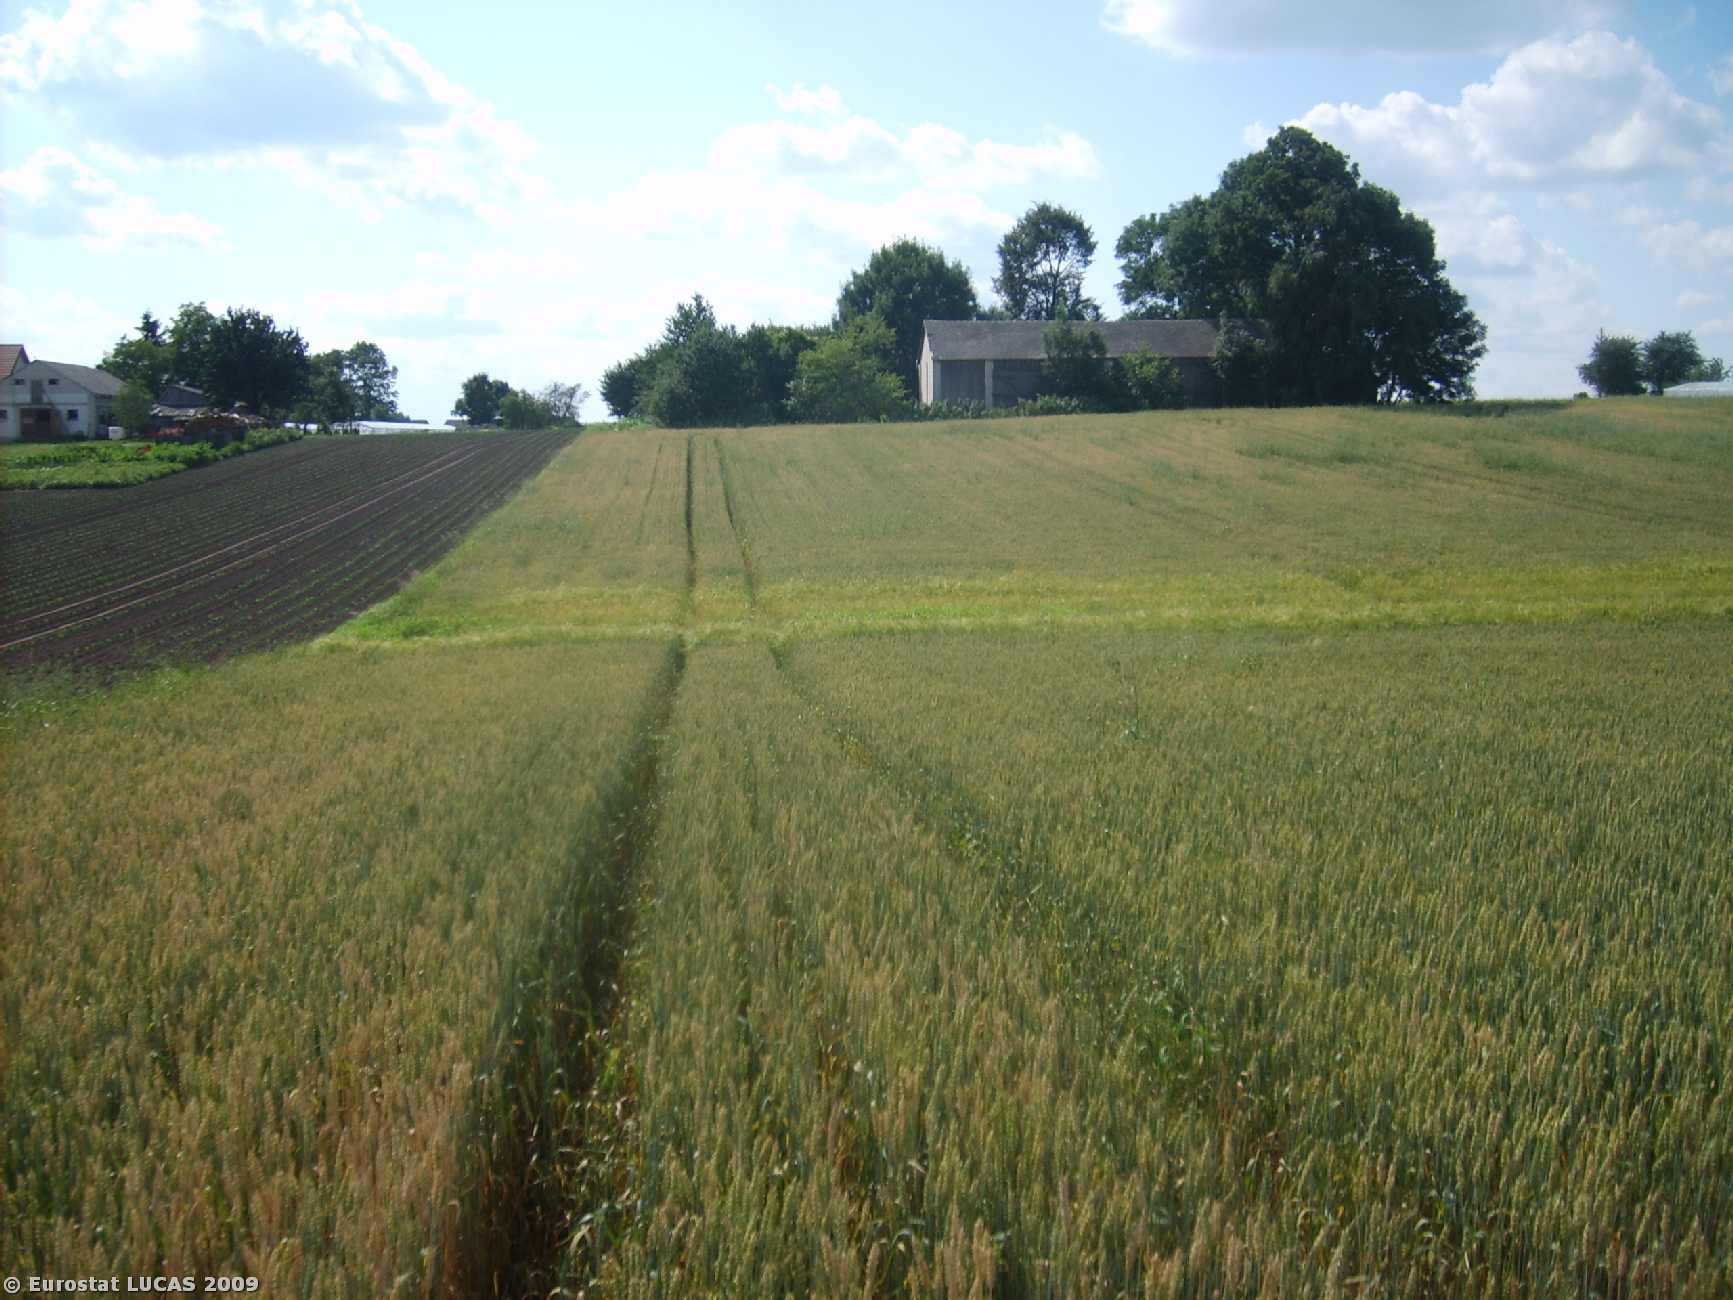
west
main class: Cropland
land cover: Common wheat
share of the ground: > 75 %
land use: Agriculture (excluding fallow land and kitchen gardens)
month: July
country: PL
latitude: 50.5419
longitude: 23.8199
